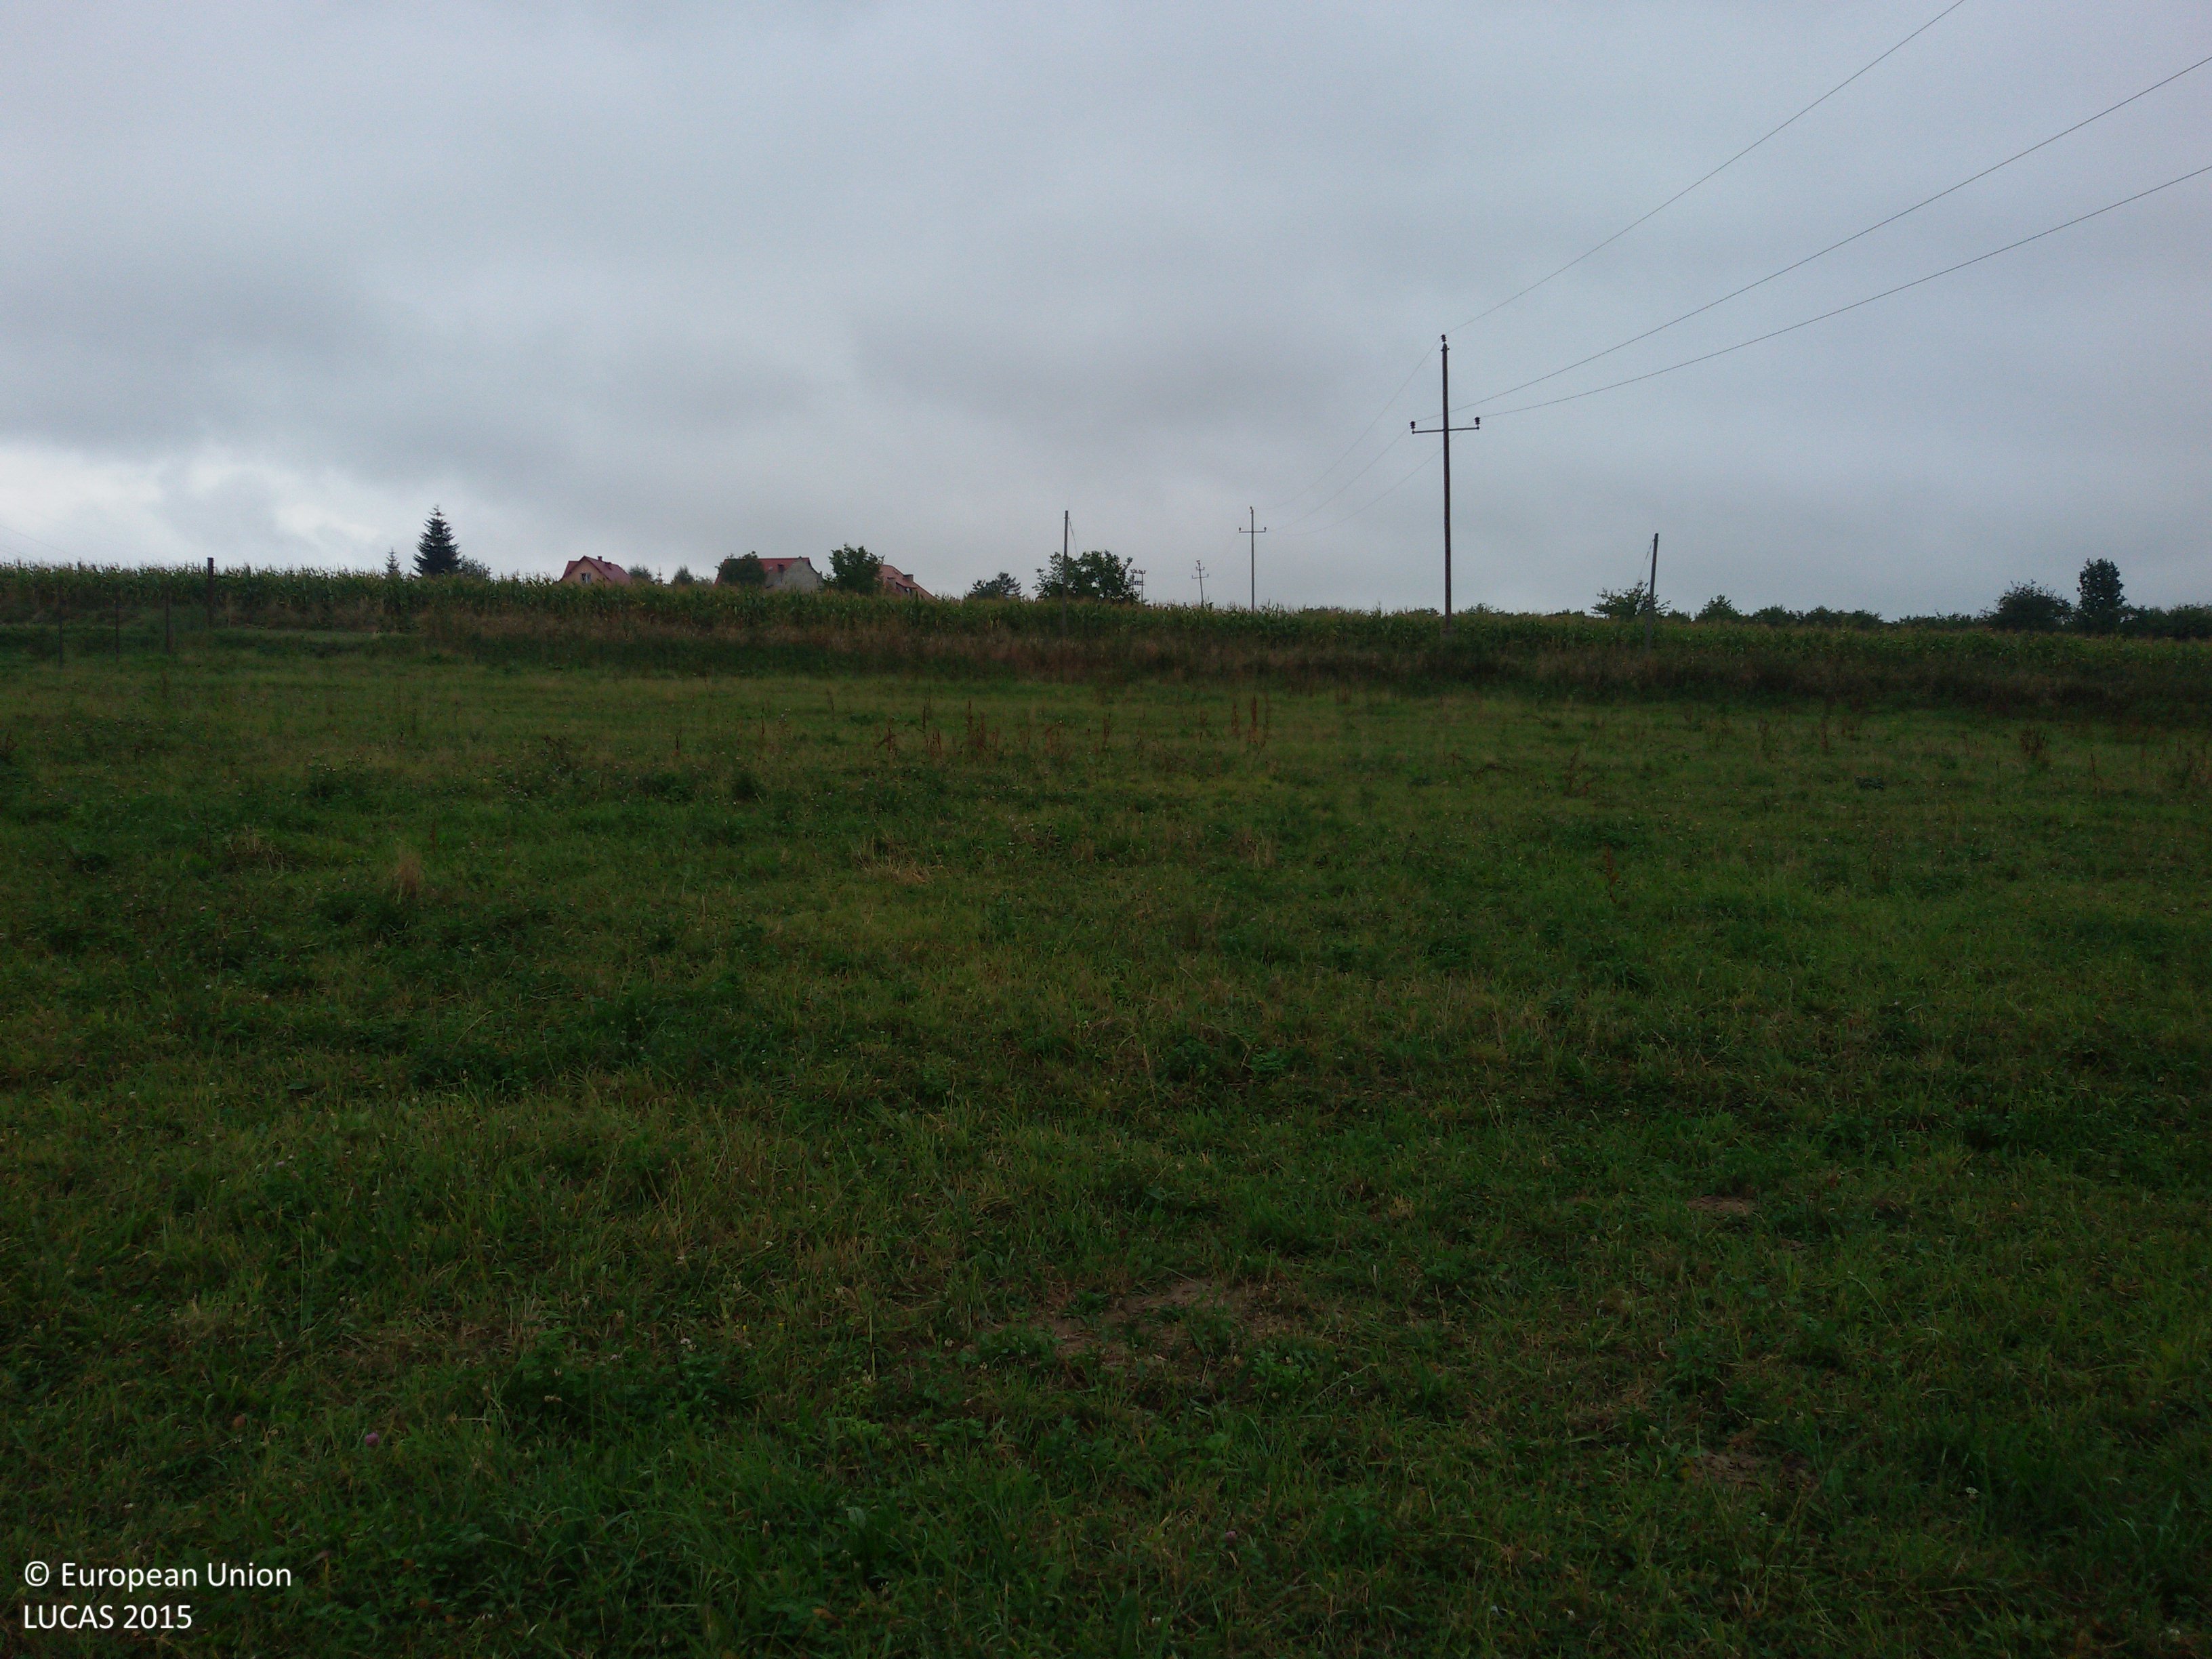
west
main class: Grassland
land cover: Grassland without tree/shrub cover
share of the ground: > 75 %
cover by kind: herbaceous plants 100 %
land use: Agriculture (excluding fallow land and kitchen gardens)
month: September
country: PL
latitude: 49.6314
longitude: 20.6302
